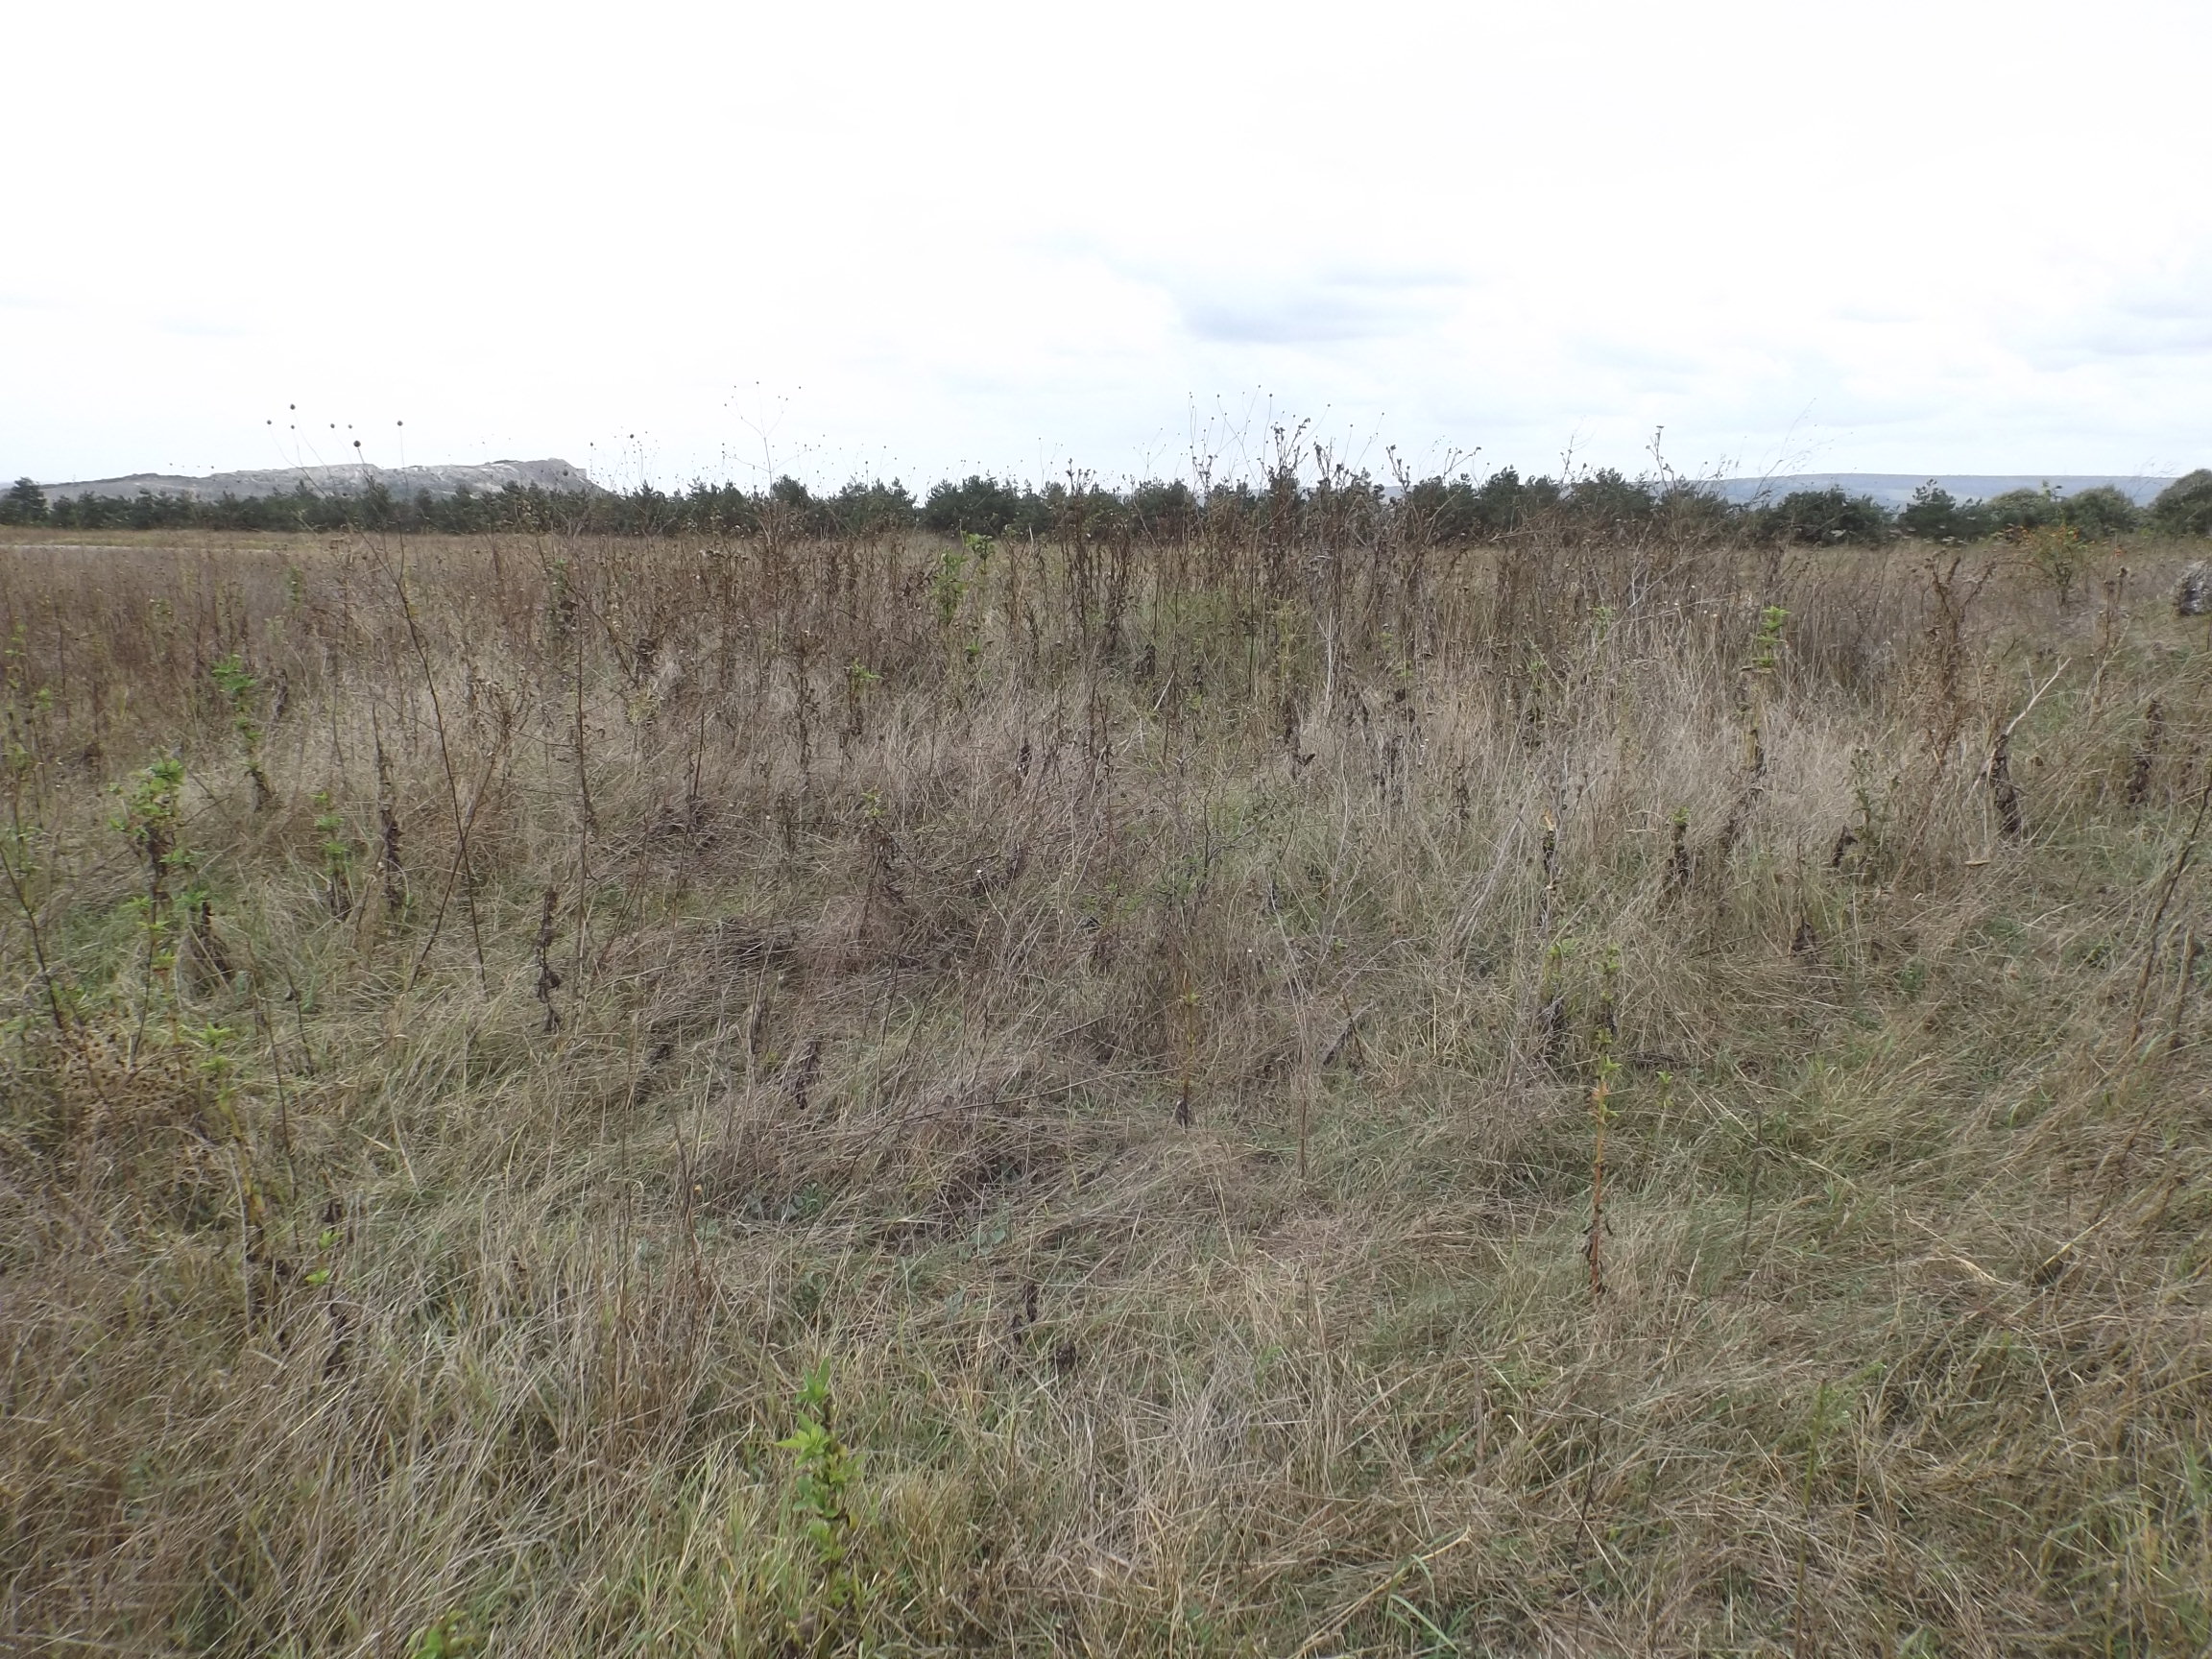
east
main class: Grassland
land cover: Spontaneously vegetated surfaces
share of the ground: > 75 %
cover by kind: herbaceous plants 95 %, shrubs 5 %
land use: Semi-natural and natural areas not in use
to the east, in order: Spontaneously vegetated surfaces; Ditches and canals; Spontaneously vegetated surfaces; Pine dominated coniferous woodland
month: September
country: BG
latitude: 43.1706
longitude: 27.5587
